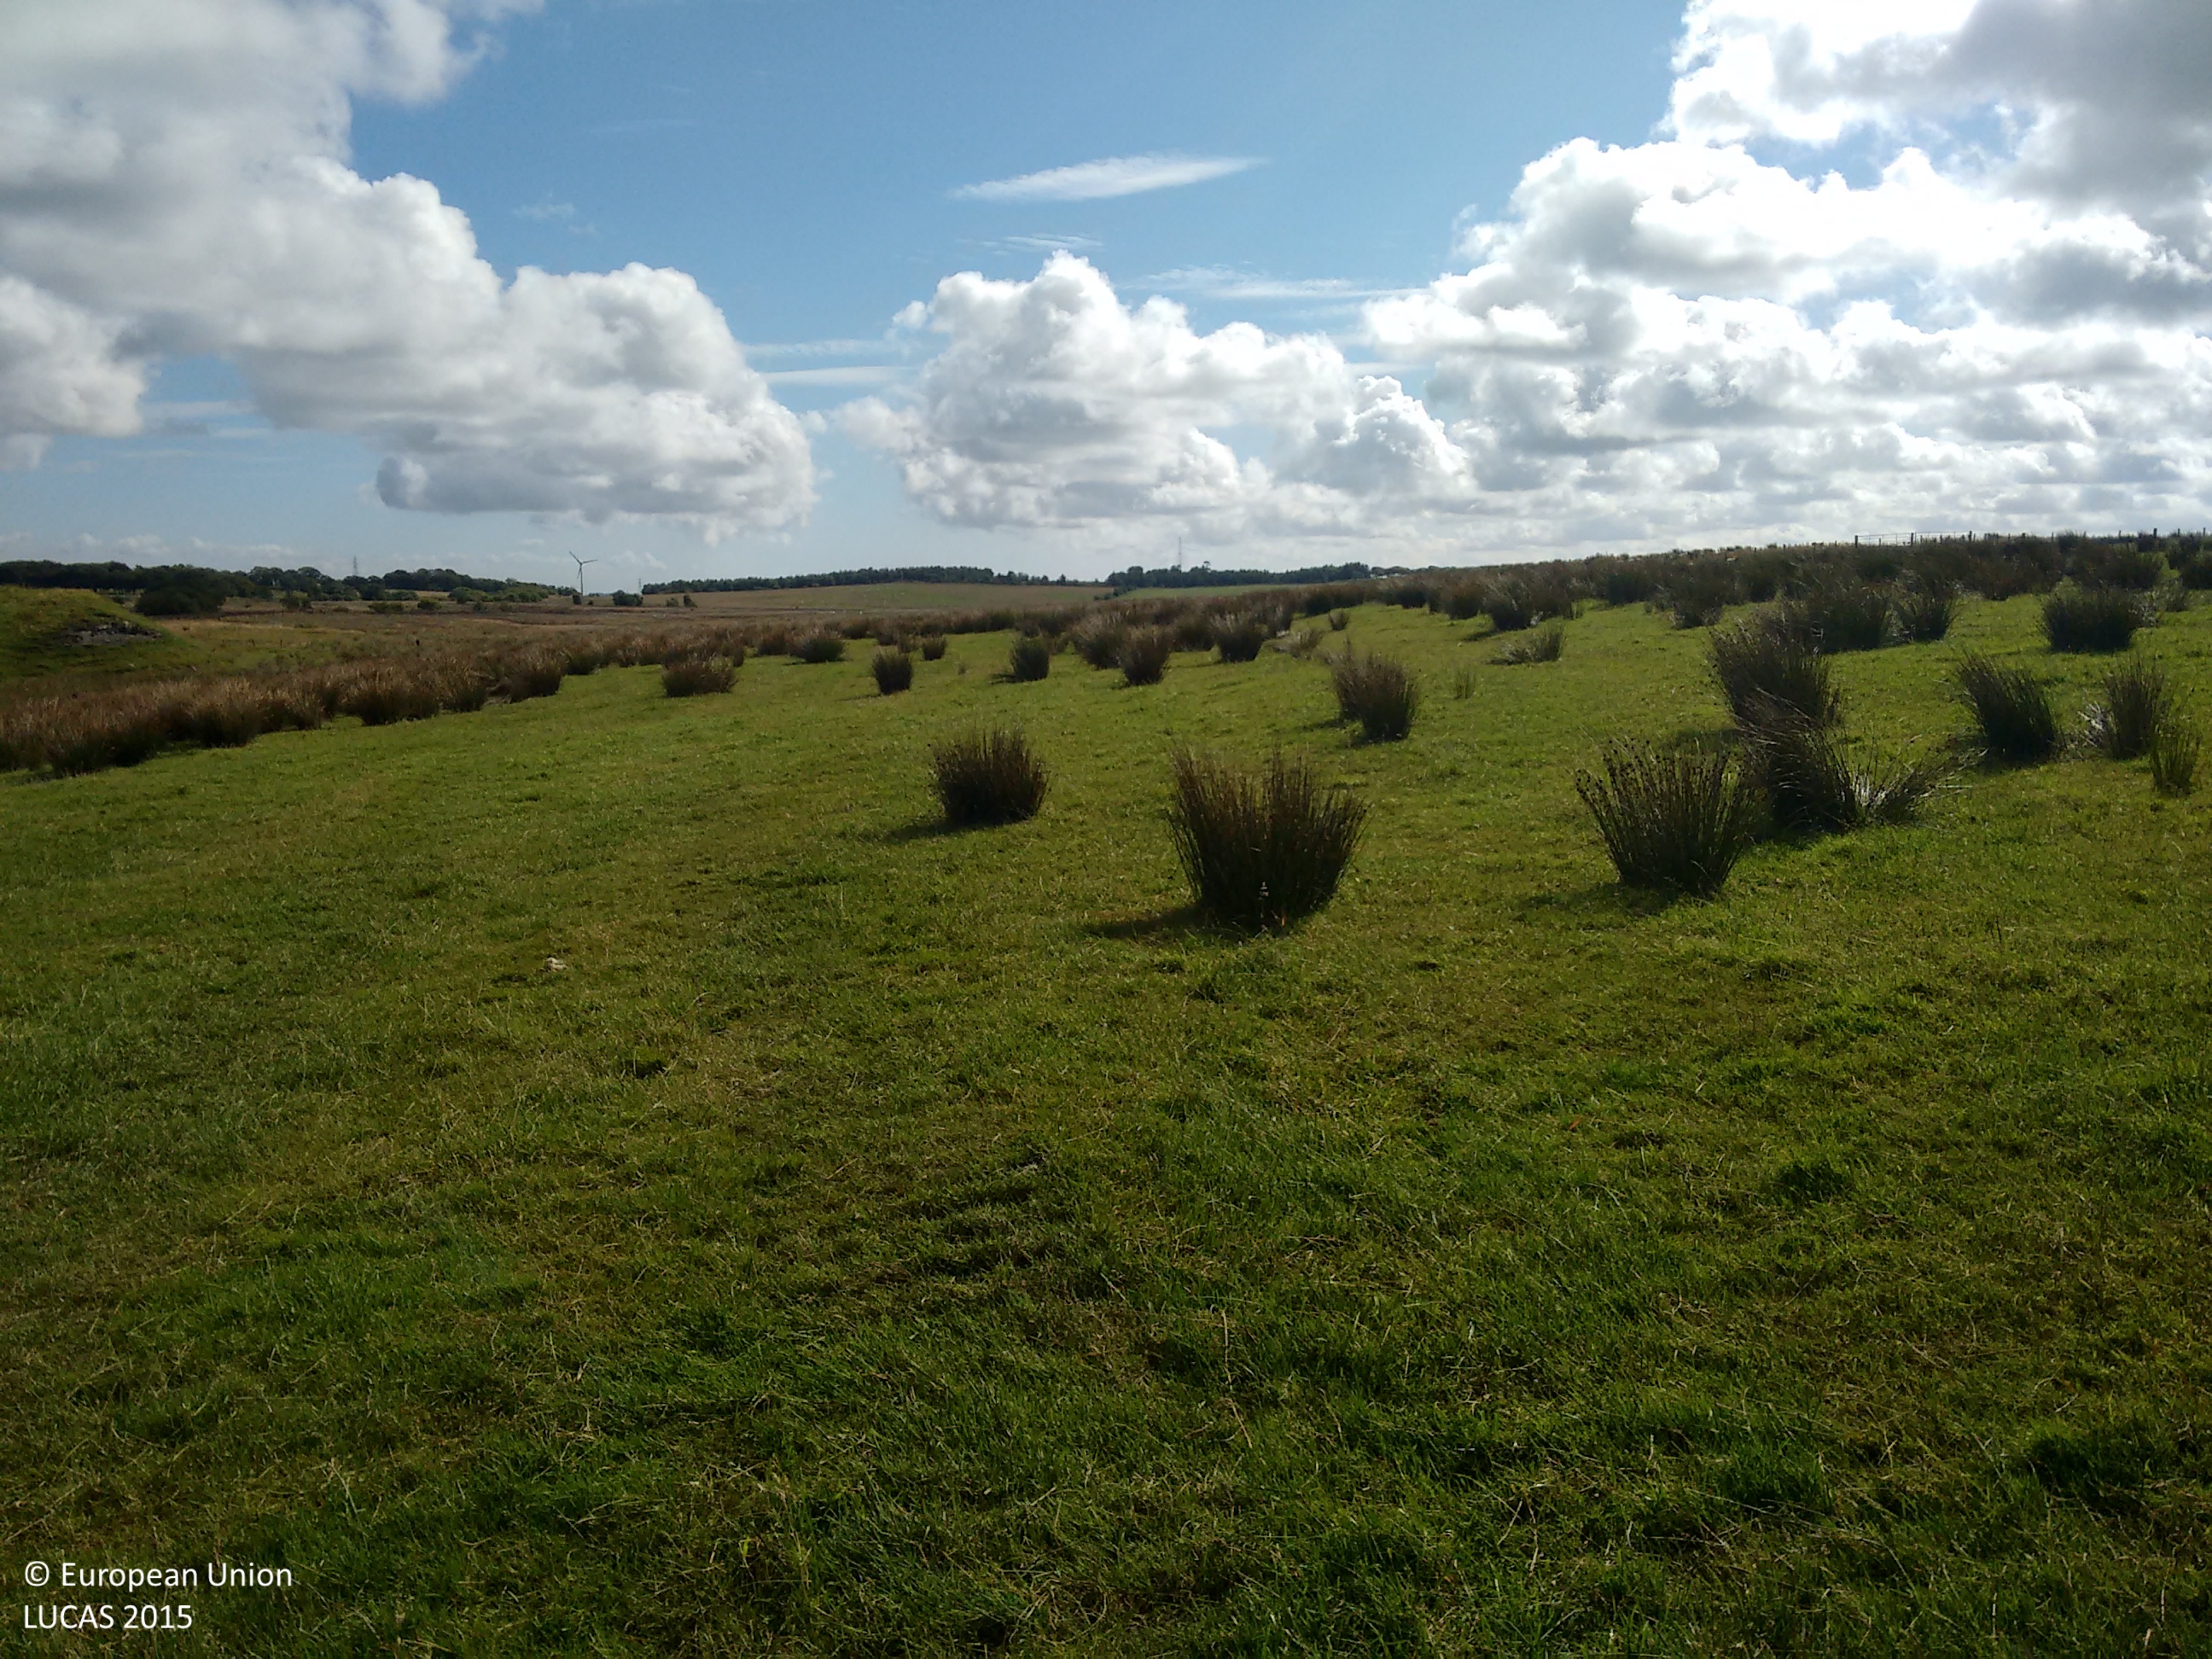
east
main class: Grassland
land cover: Grassland without tree/shrub cover
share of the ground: > 75 %
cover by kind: herbaceous plants 100 %
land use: Agriculture (excluding fallow land and kitchen gardens)
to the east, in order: Grassland without tree/shrub cover; Fences; Grassland without tree/shrub cover
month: August
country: GB
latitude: 55.9515
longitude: -3.7754
